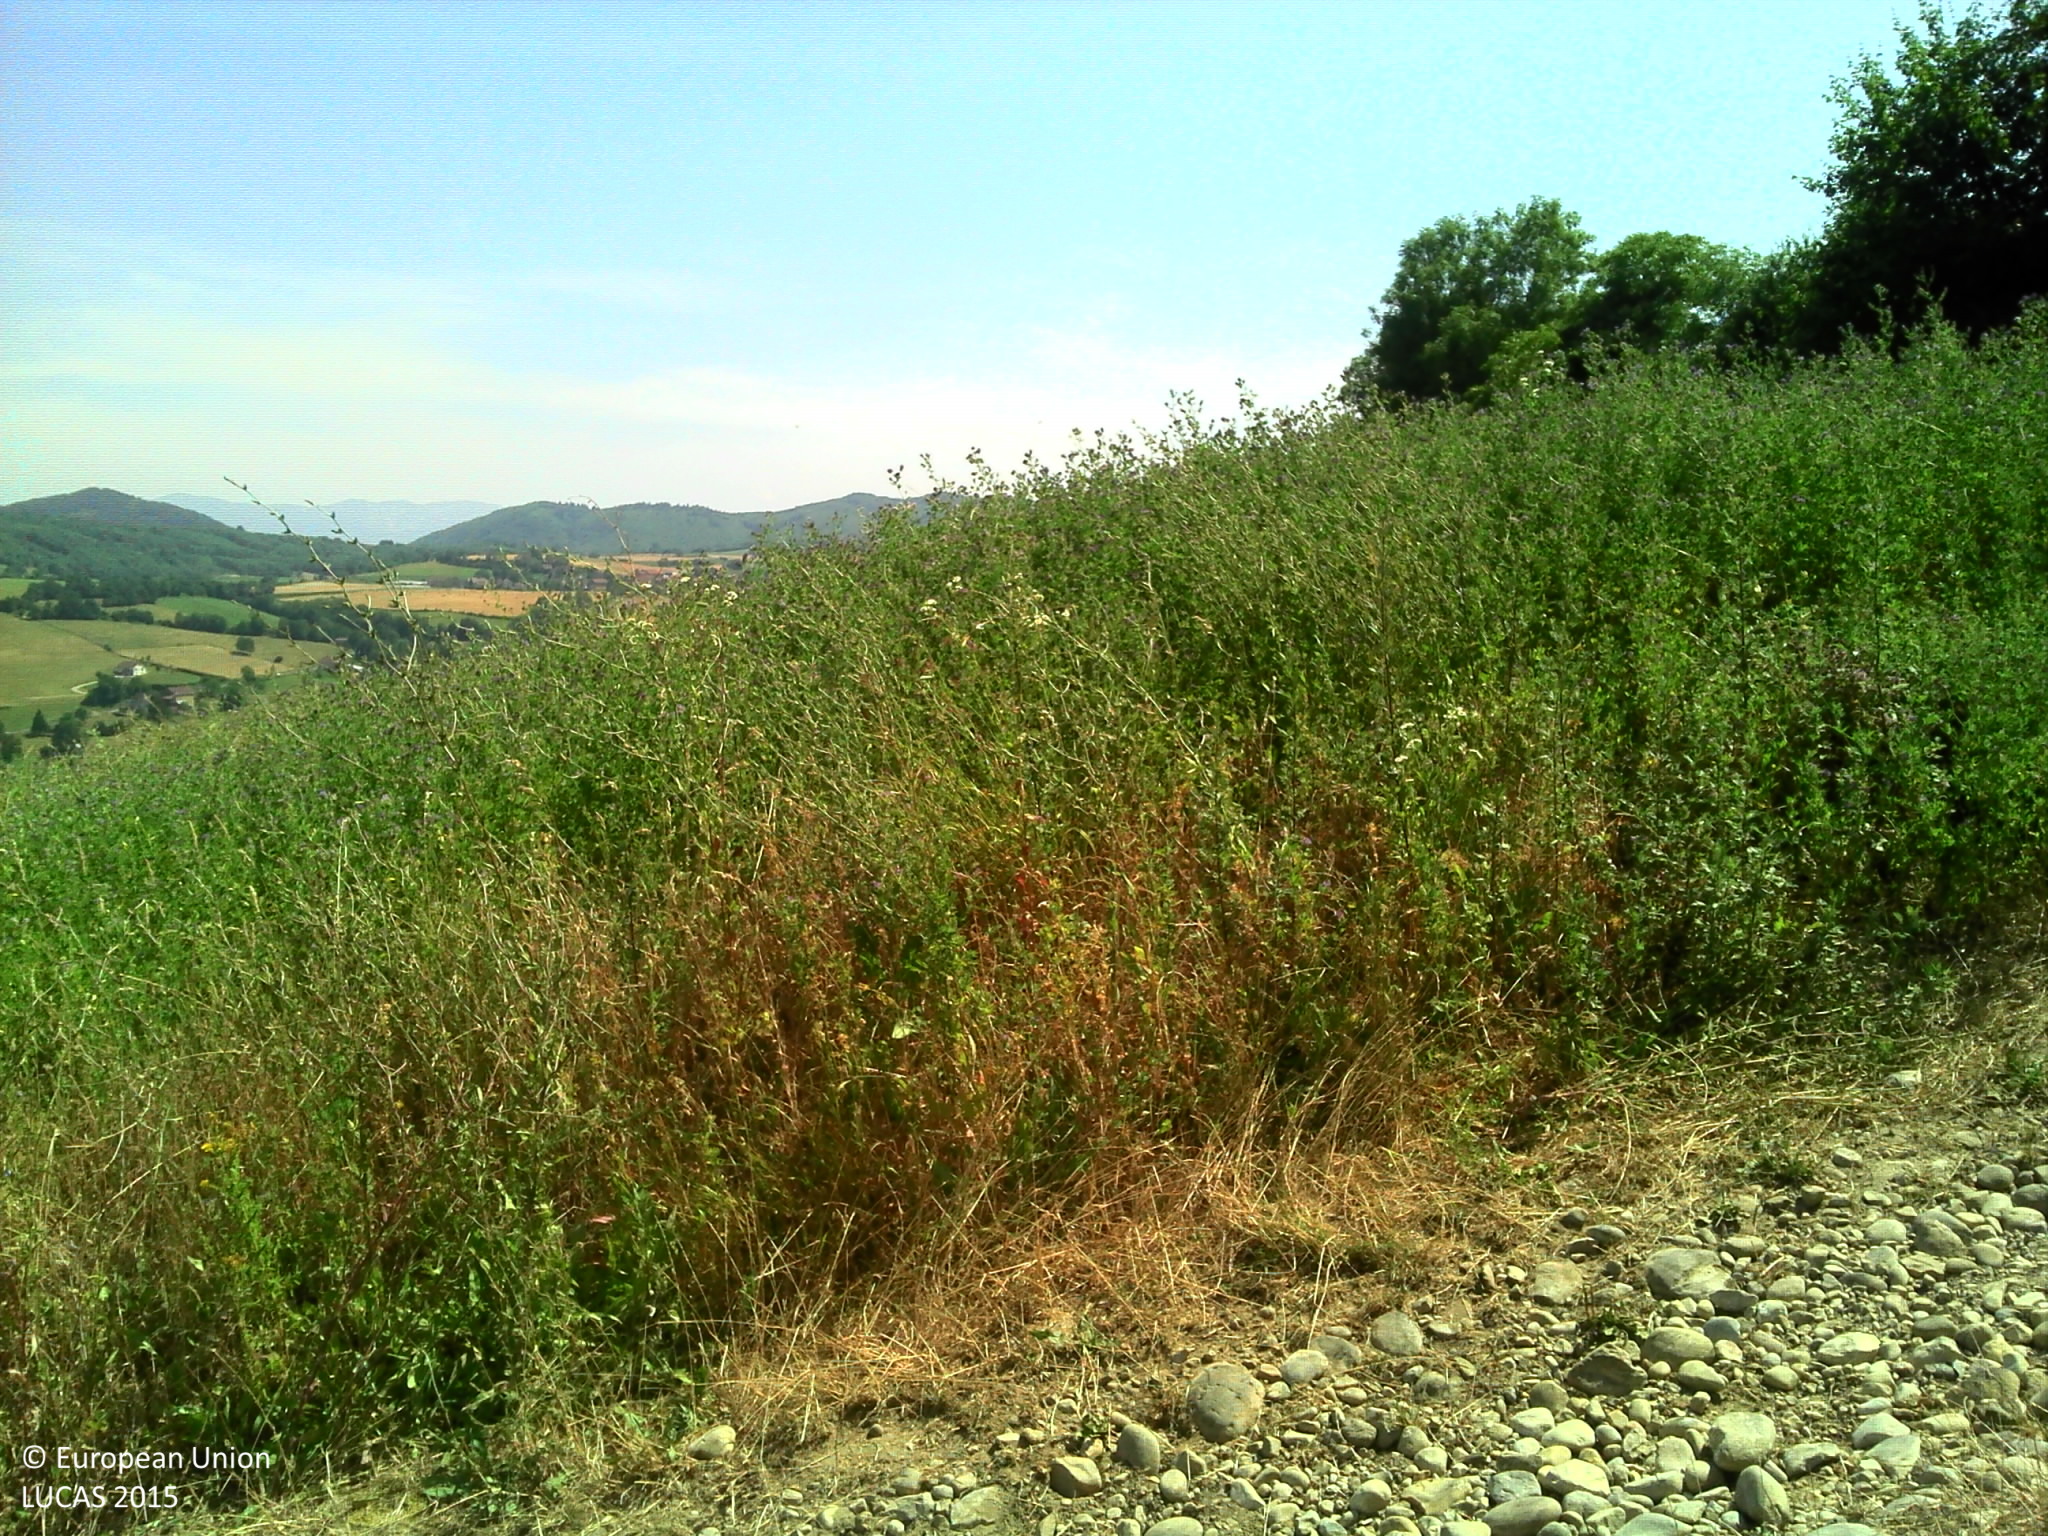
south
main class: Grassland
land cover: Grassland without tree/shrub cover
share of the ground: > 75 %
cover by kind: herbaceous plants 100 %
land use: Agriculture (excluding fallow land and kitchen gardens)
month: July
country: FR
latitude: 45.4600
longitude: 5.4392
